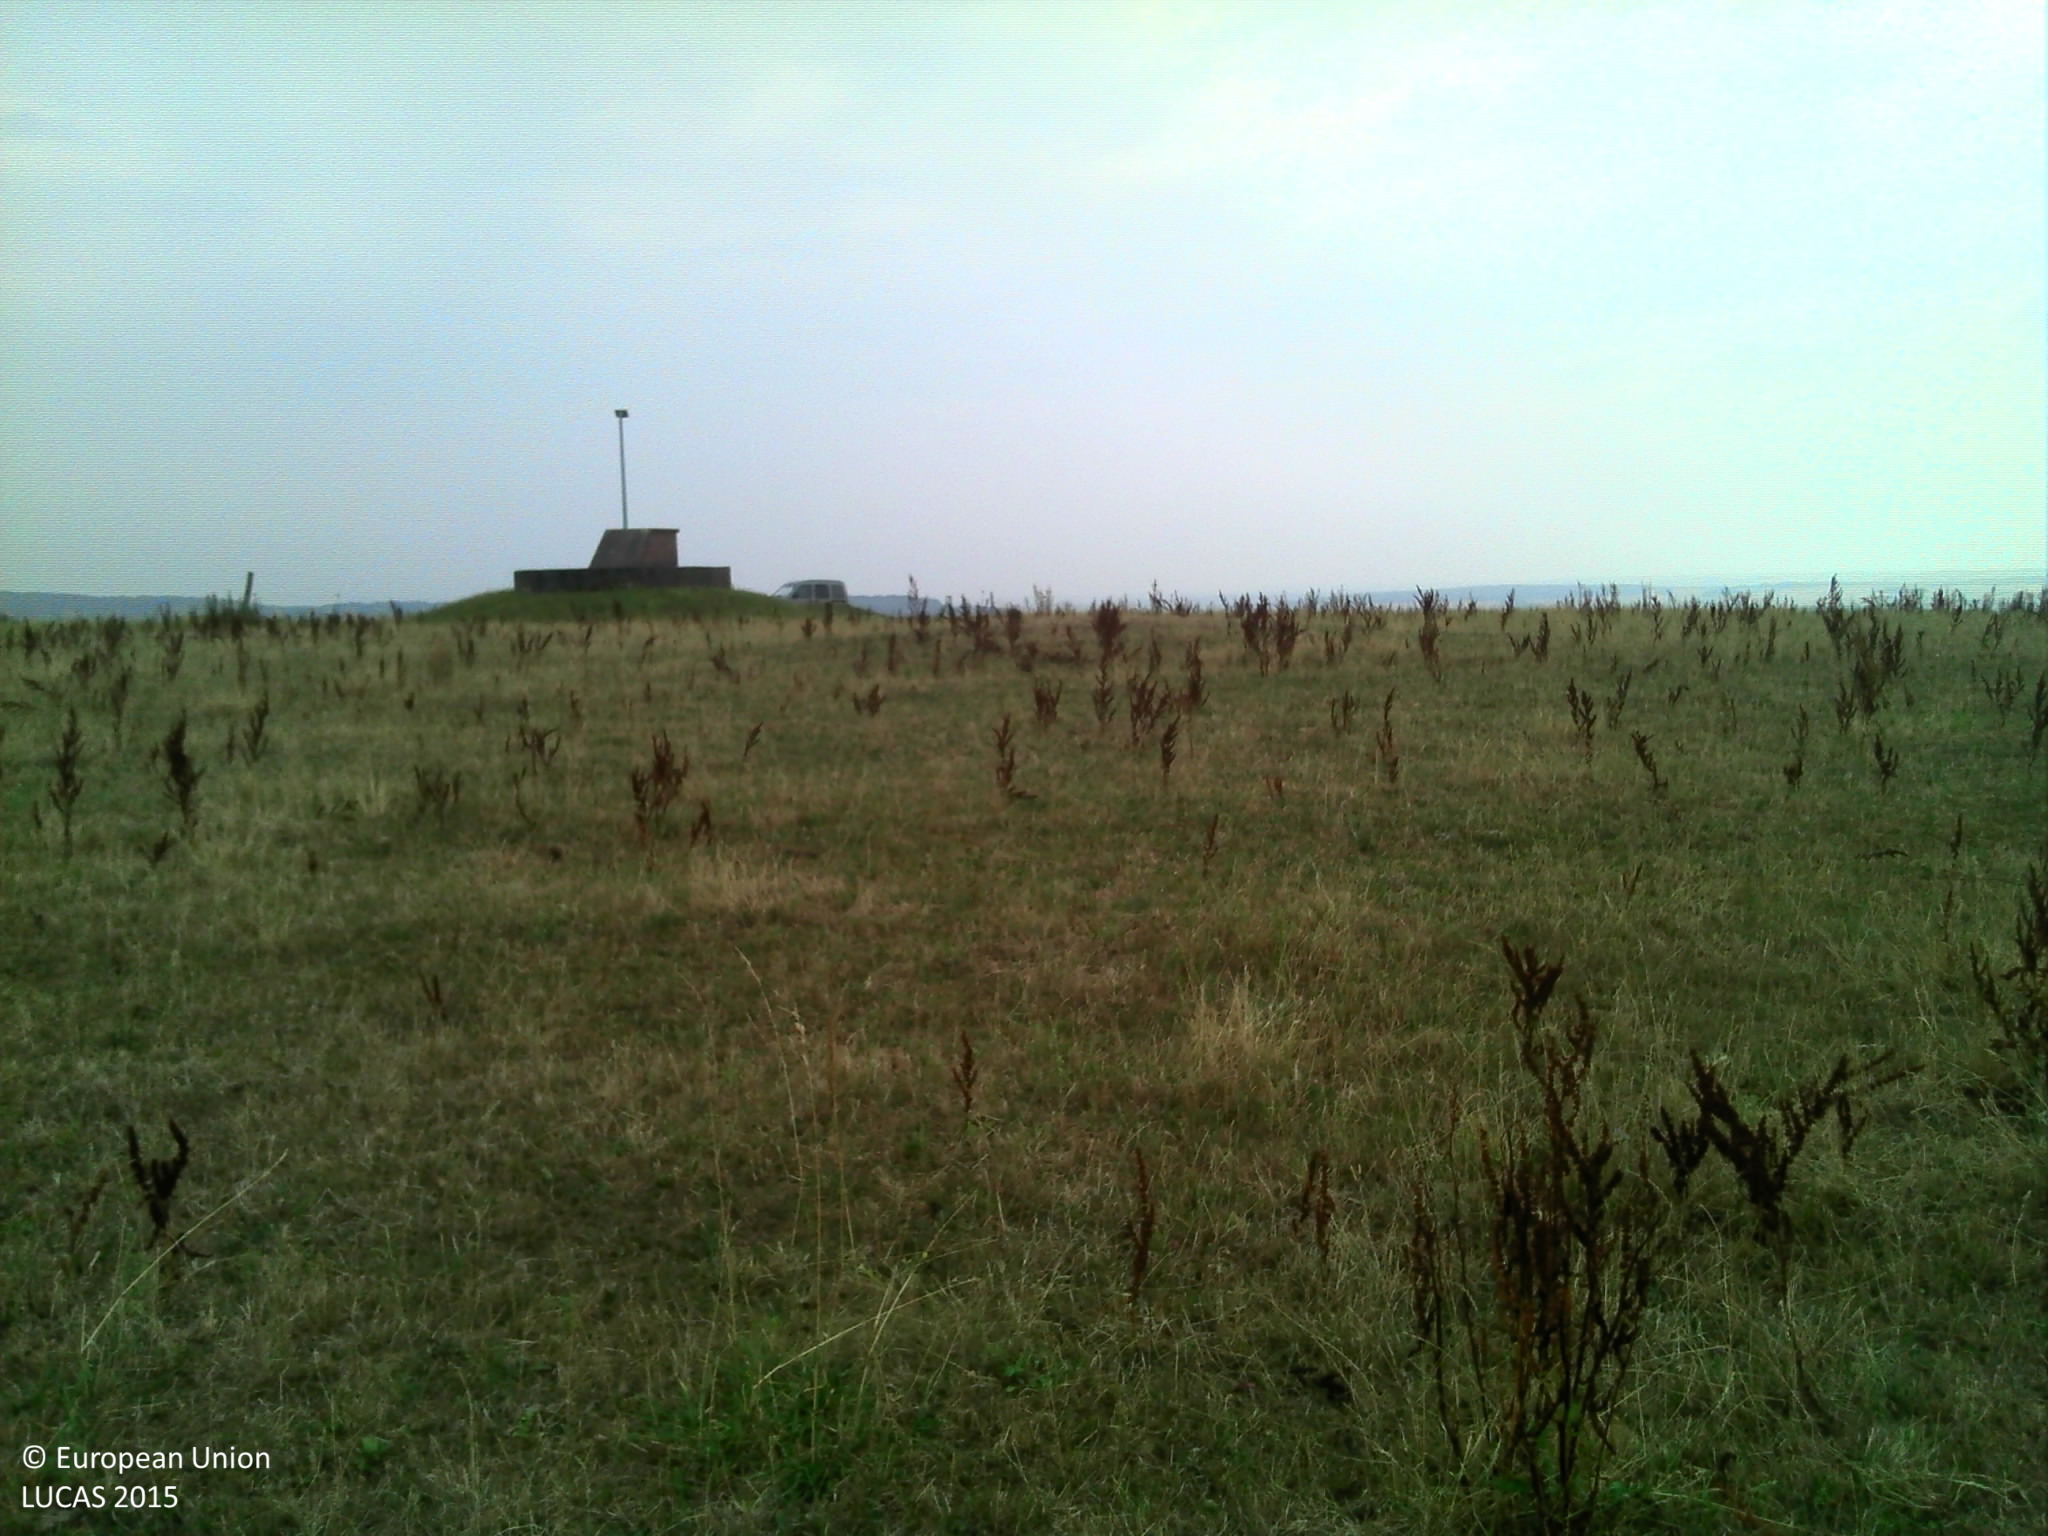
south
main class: Grassland
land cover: Grassland without tree/shrub cover
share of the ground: > 75 %
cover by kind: herbaceous plants 100 %
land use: Agriculture (excluding fallow land and kitchen gardens)
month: August
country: FR
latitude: 49.3478
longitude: 5.2767
